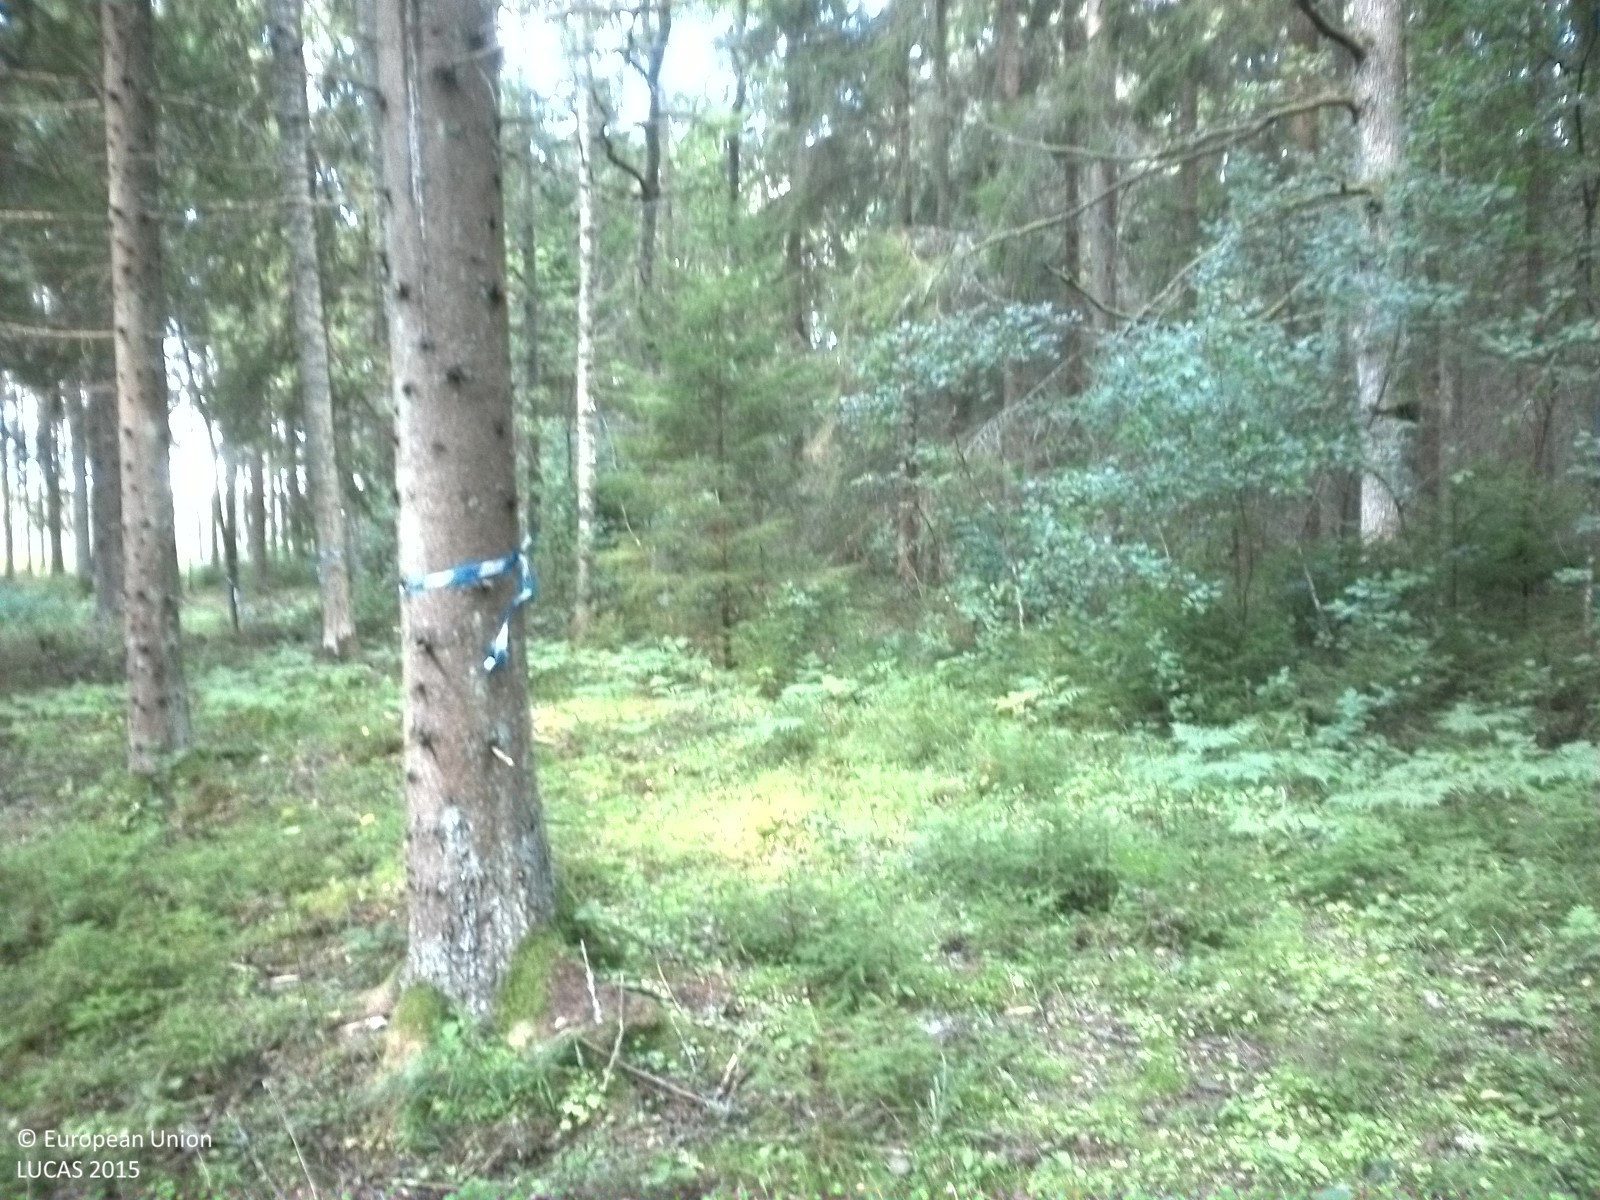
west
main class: Woodland
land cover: Spruce dominated coniferous woodland
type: boreal forest
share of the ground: 25 - 50 %
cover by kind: coniferous forest trees 40 %, lichens and mosses 30 %, herbaceous plants 25 %, broadleaved forest trees 5 %
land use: Forestry
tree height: > 5 m
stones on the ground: < 10 %
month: August
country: SE
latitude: 59.1475
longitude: 15.6392
